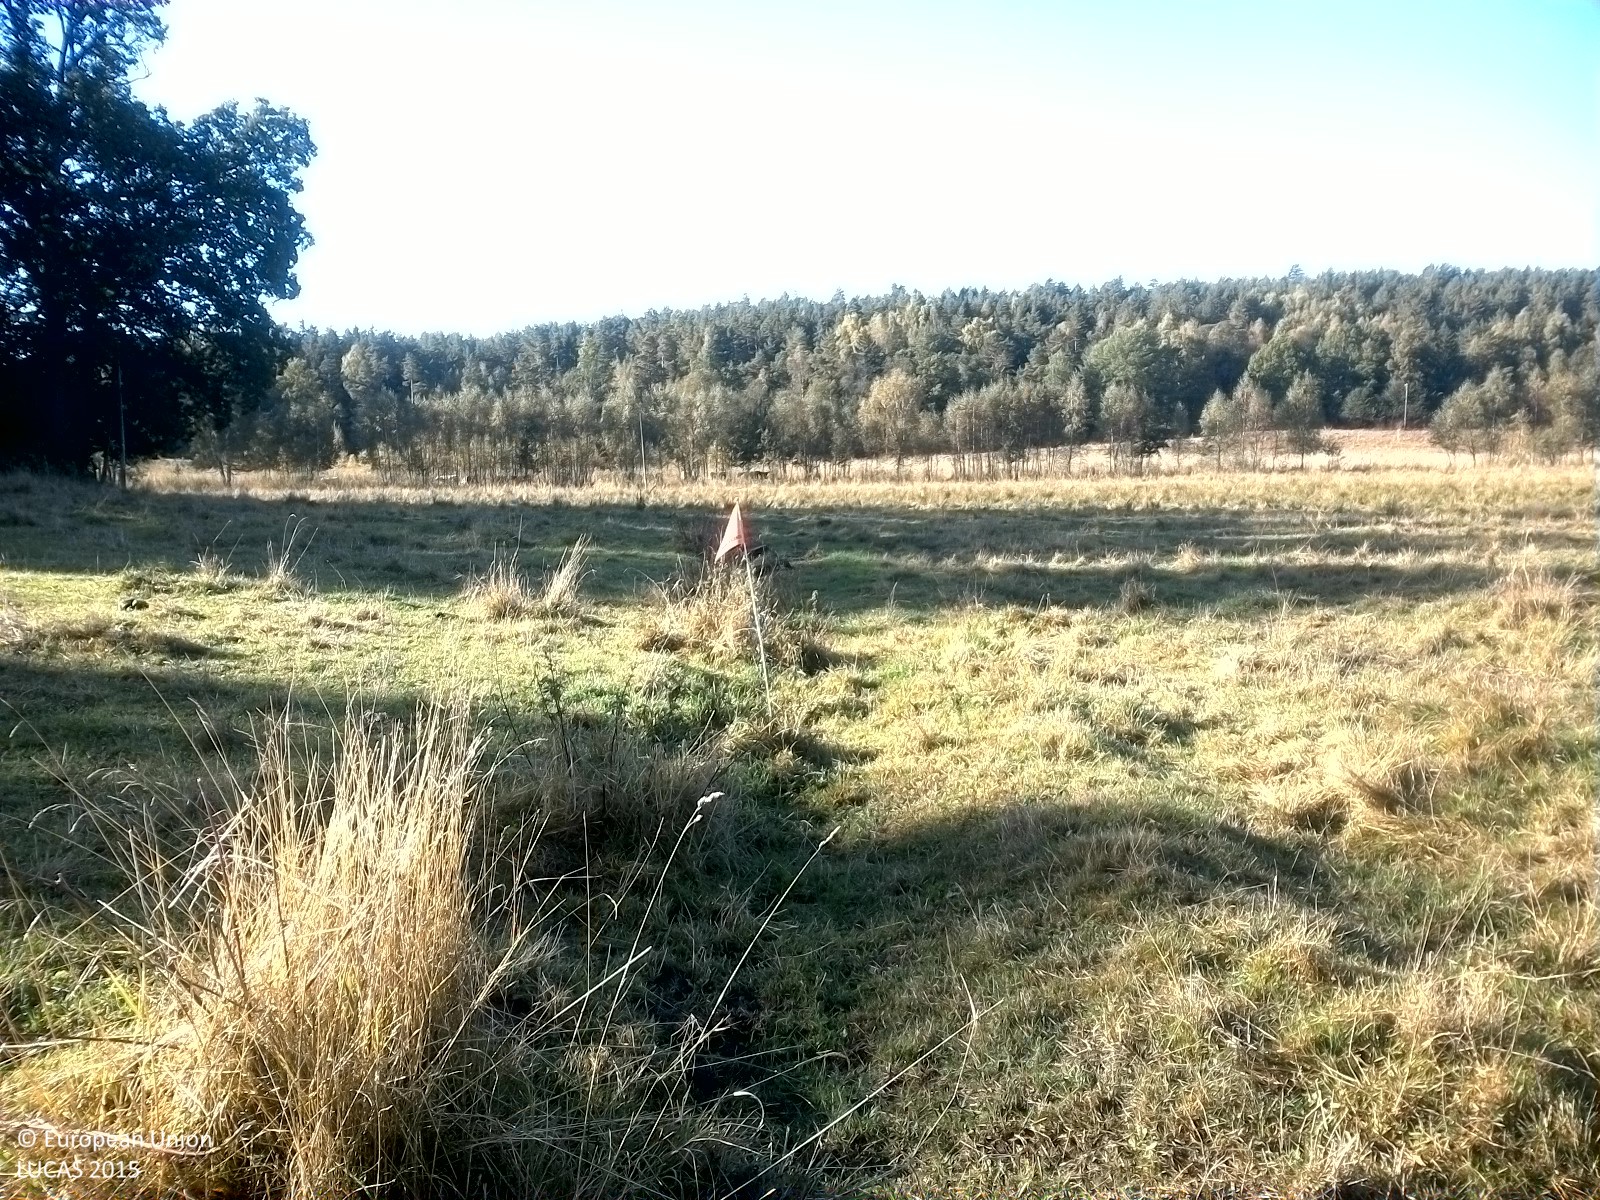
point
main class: Grassland
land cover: Grassland without tree/shrub cover
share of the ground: > 75 %
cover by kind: herbaceous plants 100 %
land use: Agriculture (excluding fallow land and kitchen gardens)
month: September
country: SE
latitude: 58.4465
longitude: 16.7646
